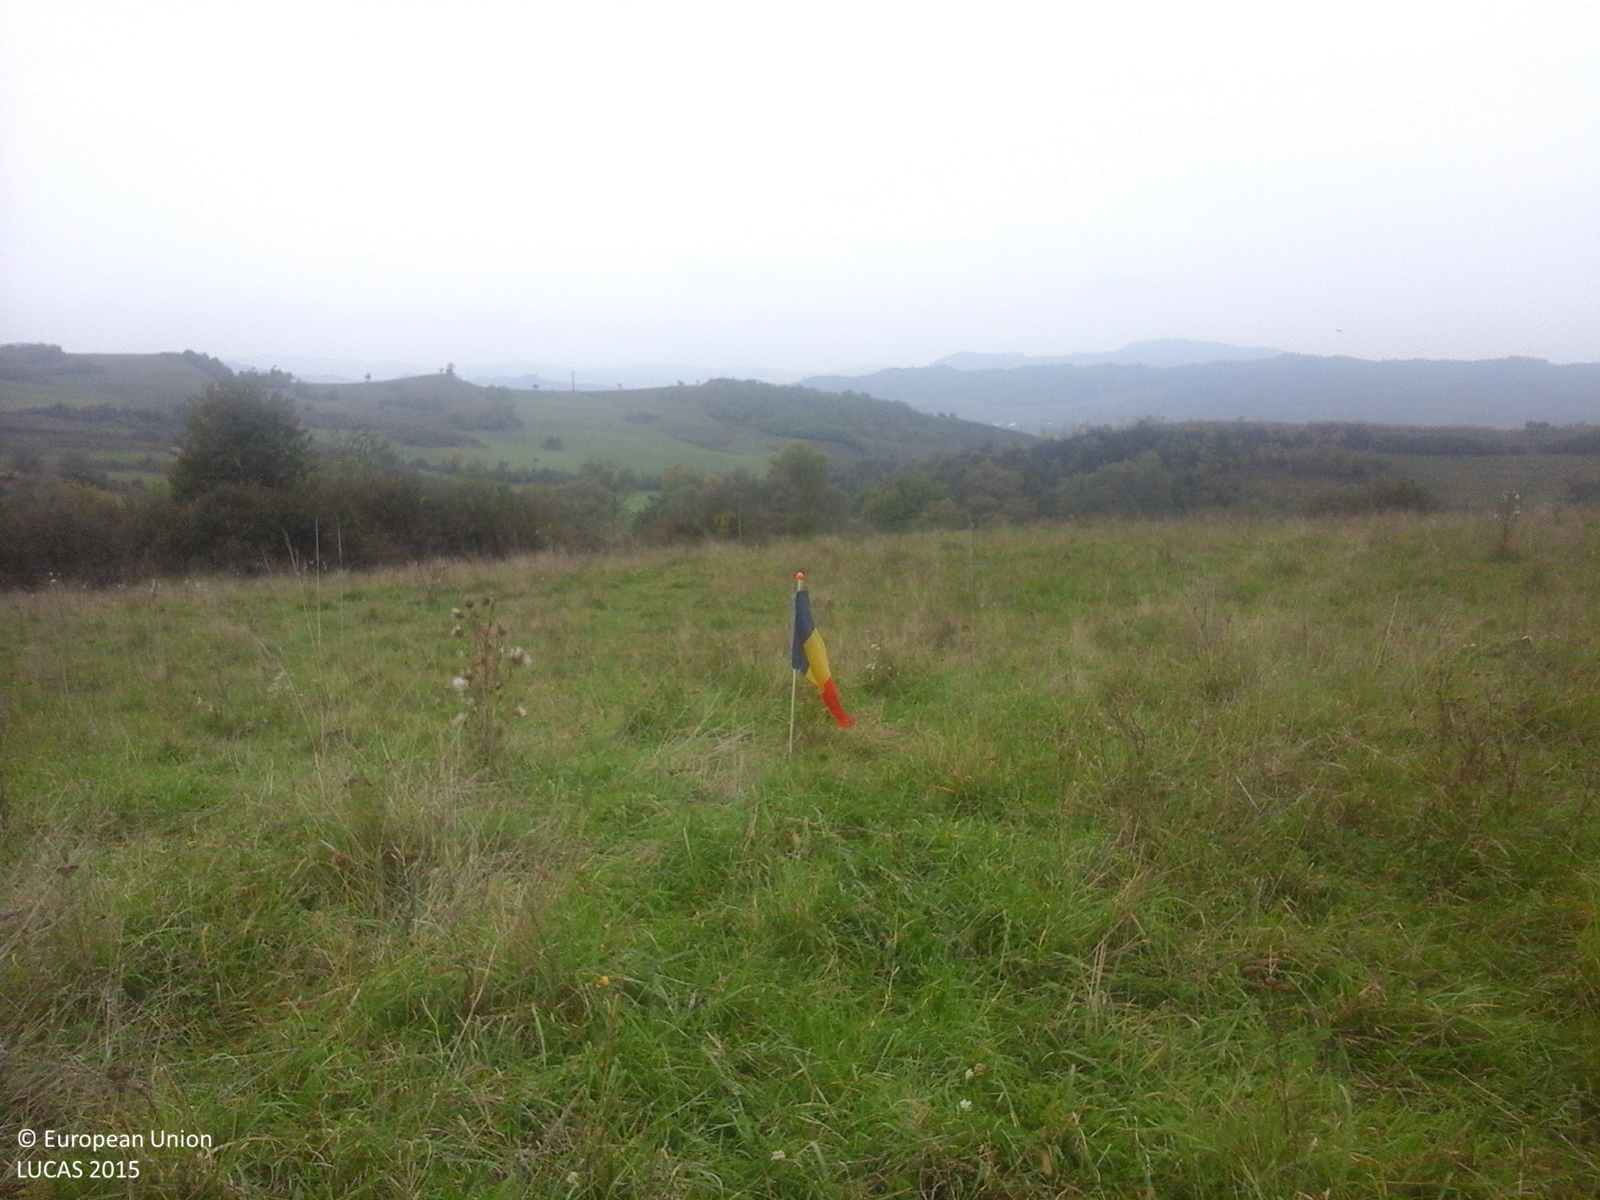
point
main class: Grassland
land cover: Grassland without tree/shrub cover
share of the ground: > 75 %
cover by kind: herbaceous plants 100 %
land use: Agriculture (excluding fallow land and kitchen gardens)
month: October
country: RO
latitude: 46.2317
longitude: 24.9145
